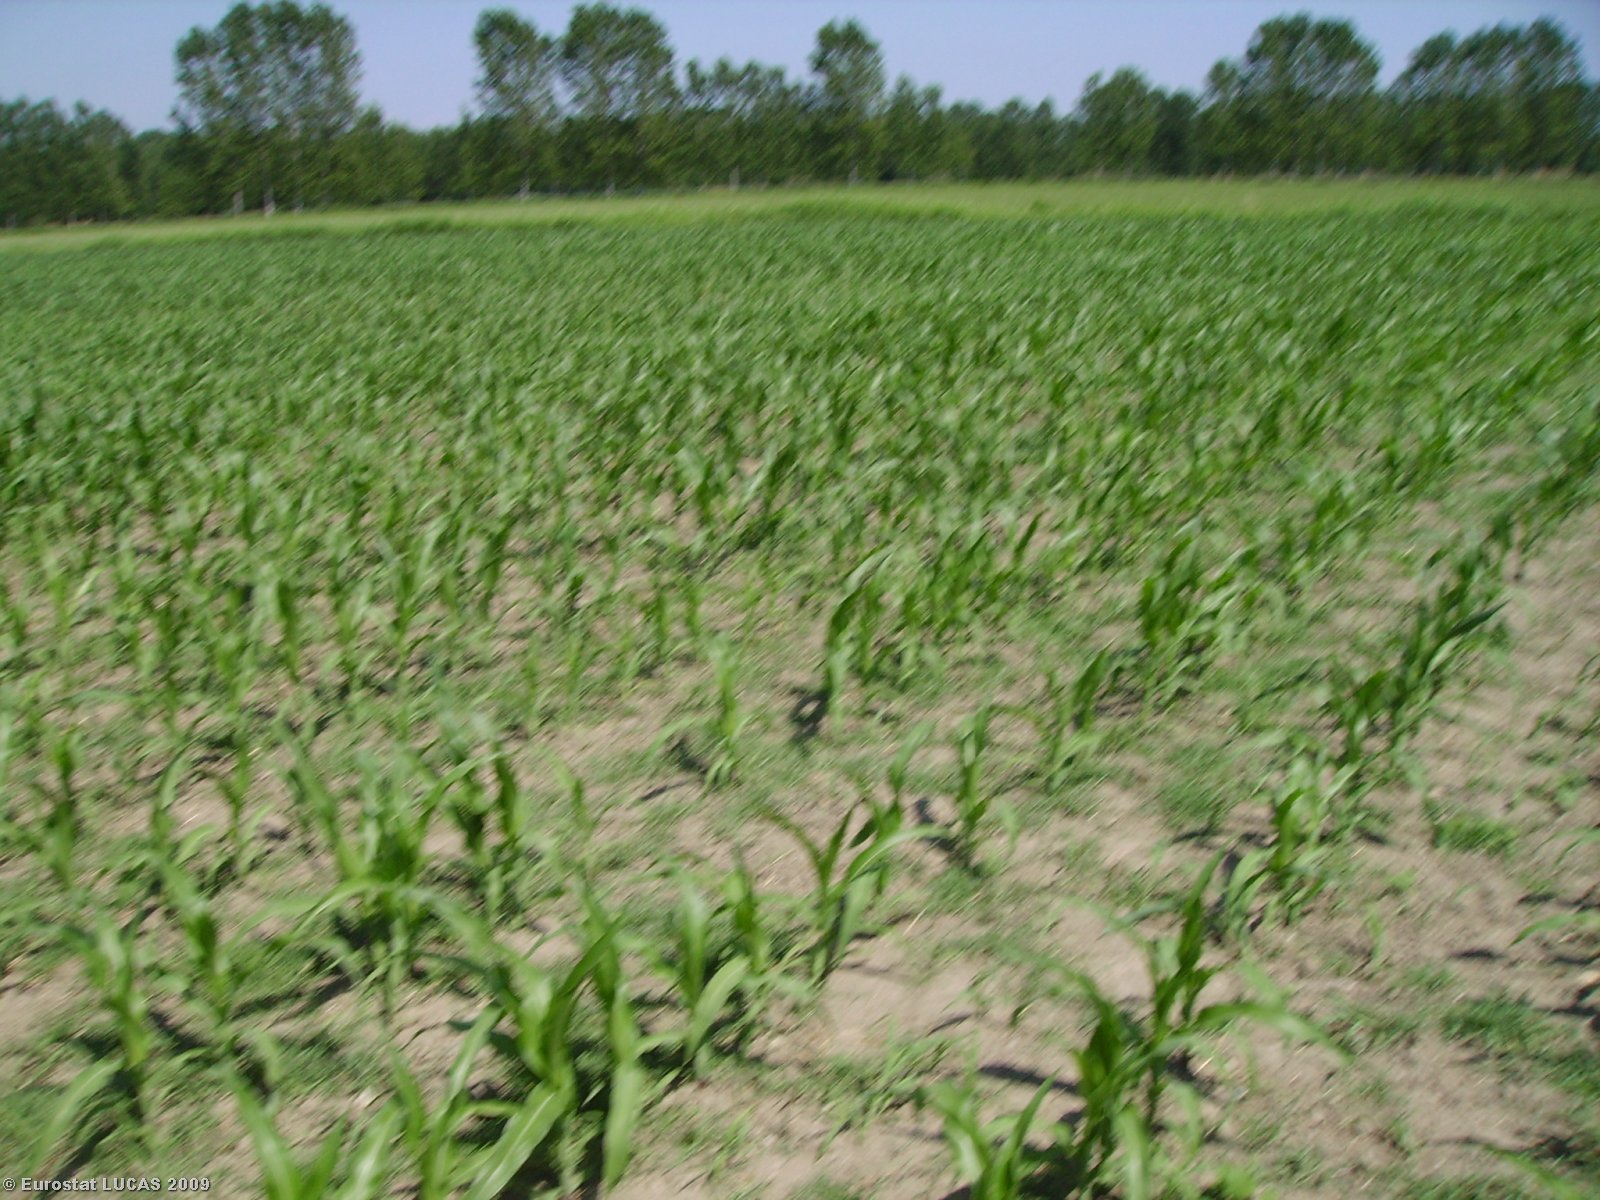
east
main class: Cropland
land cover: Maize
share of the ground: 10 - 25 %
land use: Agriculture (excluding fallow land and kitchen gardens)
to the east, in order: Maize; Grass margins; Ditches and canals; Grassland without tree/shrub cover; Single bushes/trees; Ditches and canals; Arable land (only in case pi)
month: June
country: IT
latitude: 45.3411
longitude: 9.5287
